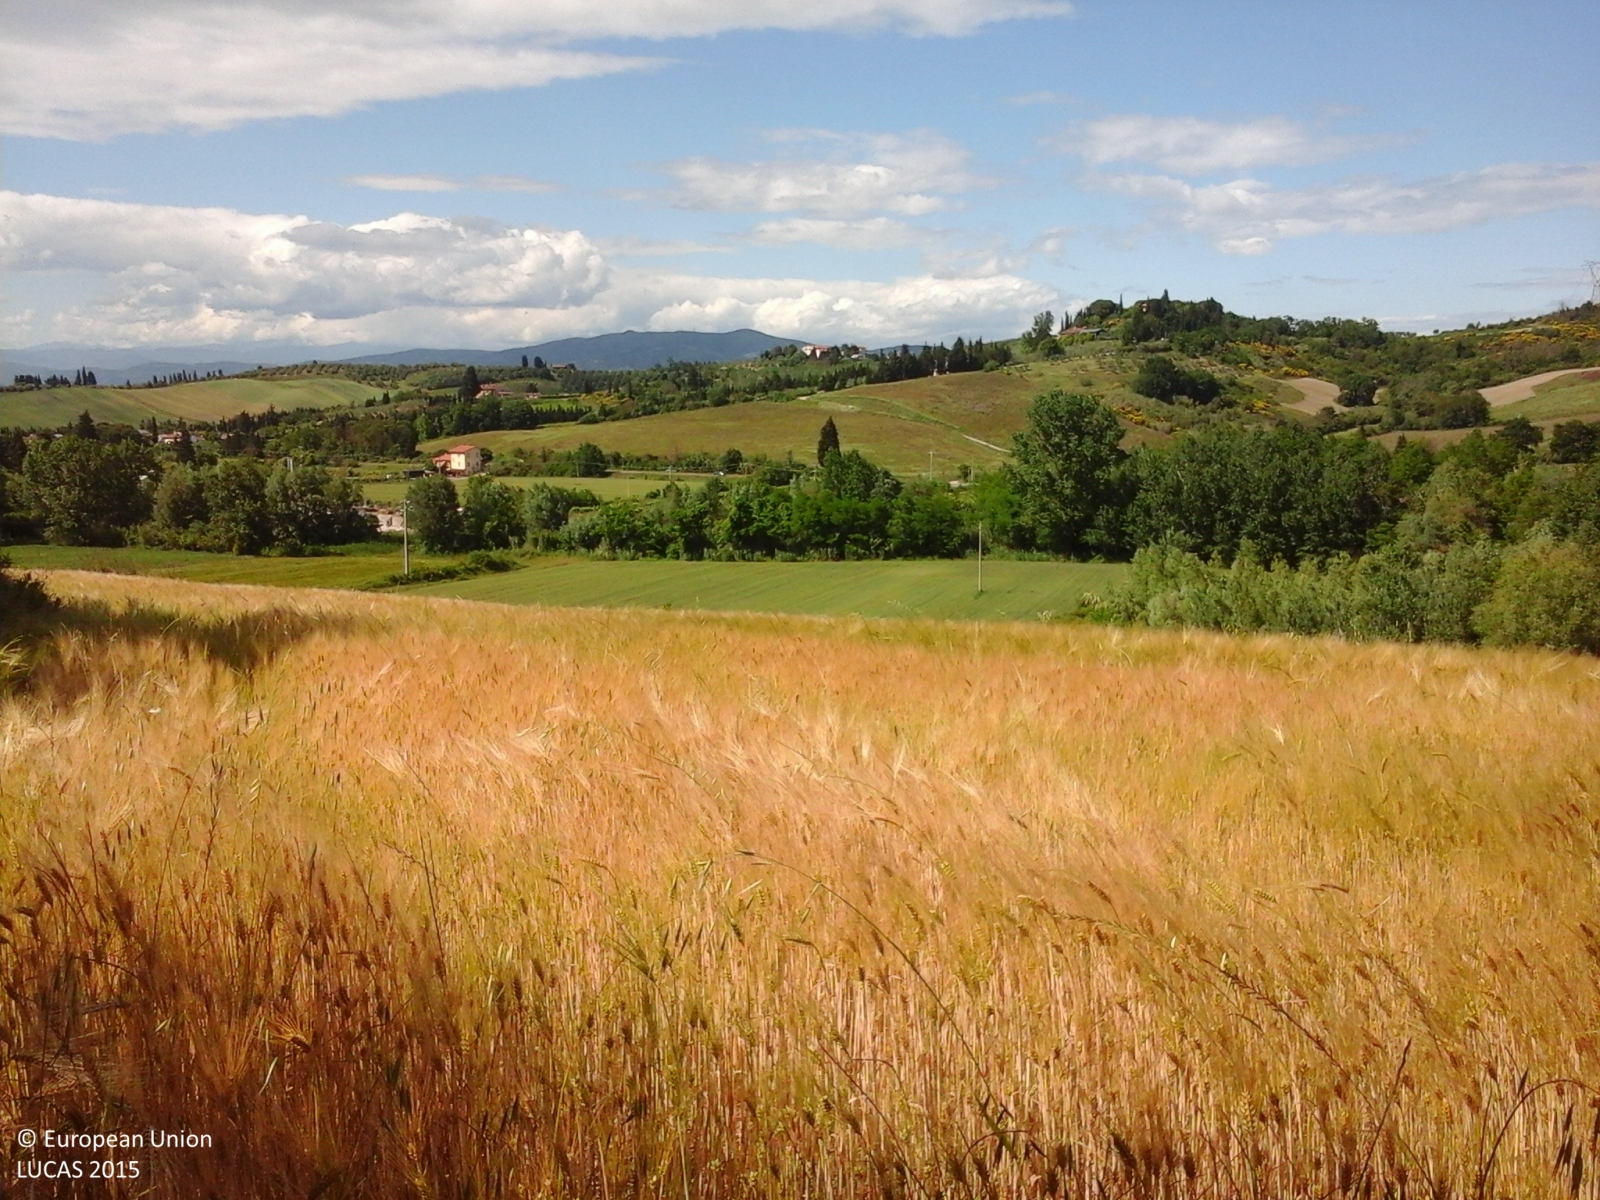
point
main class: Cropland
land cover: Durum wheat
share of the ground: > 75 %
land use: Agriculture (excluding fallow land and kitchen gardens)
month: May
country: IT
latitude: 43.6784
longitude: 10.9773
